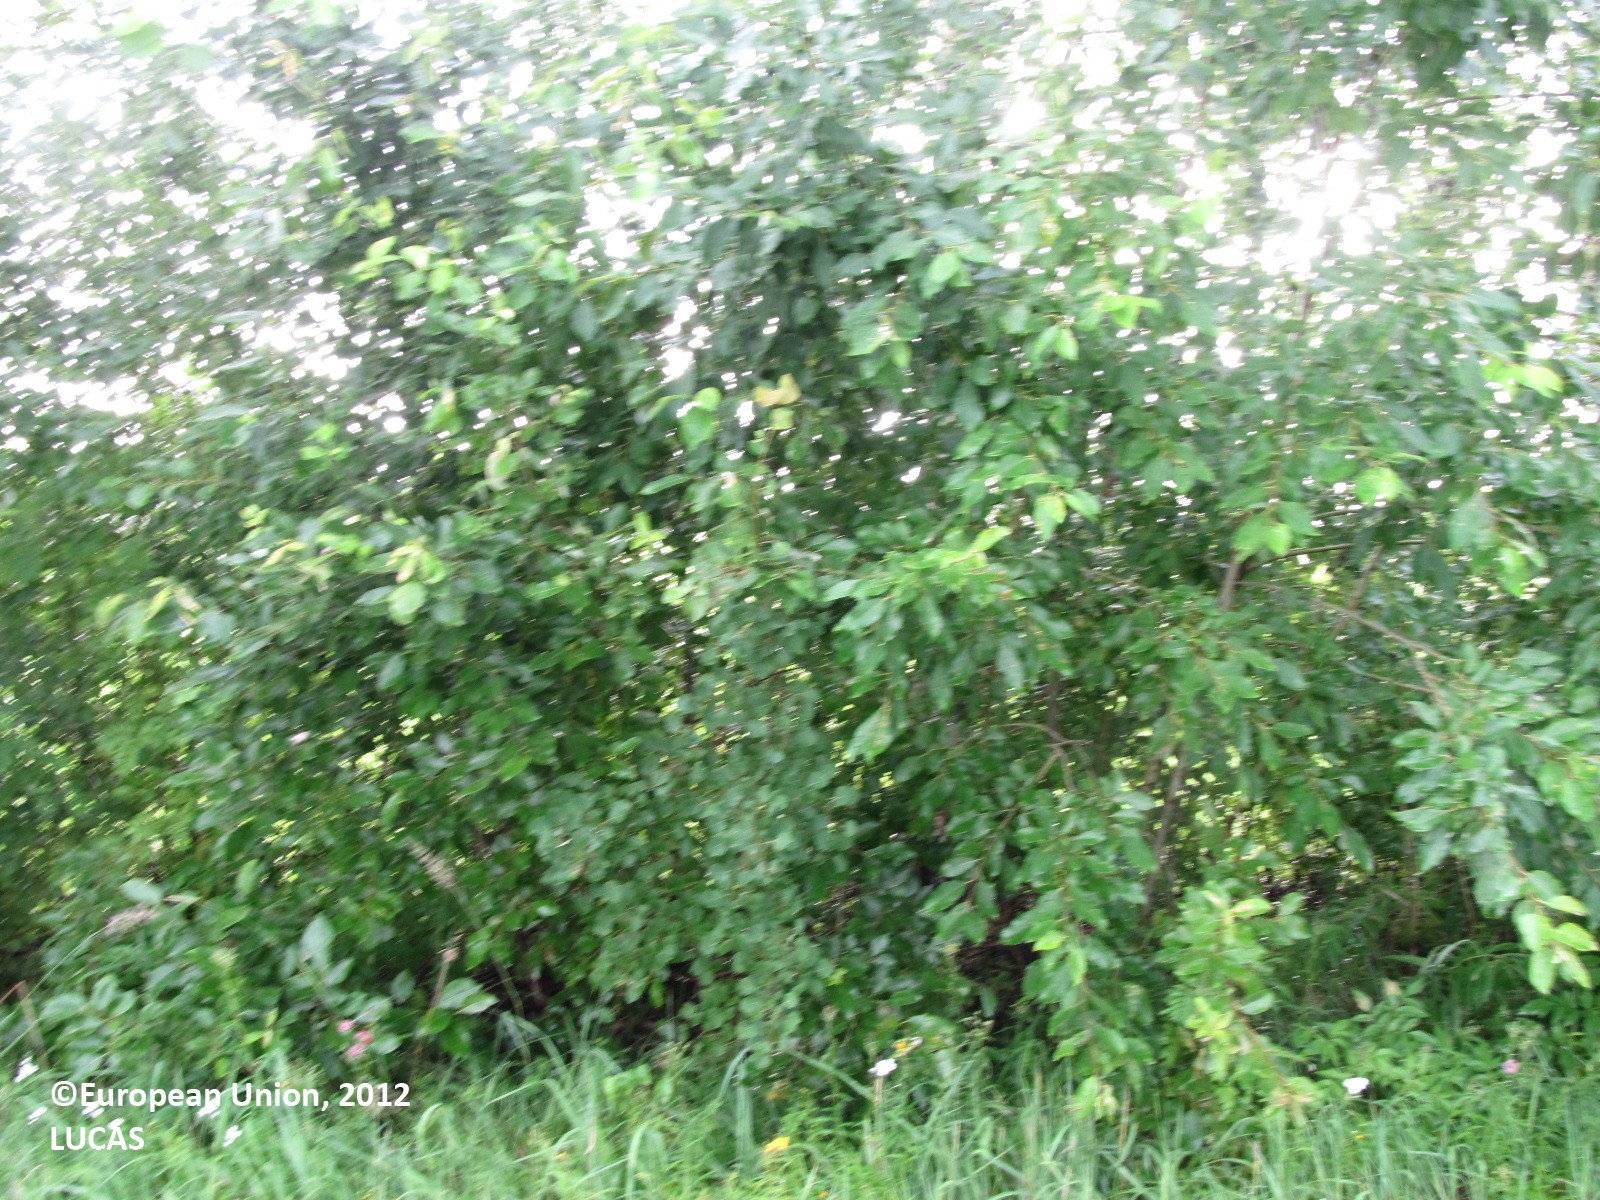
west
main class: Cropland
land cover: Oats
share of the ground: > 75 %
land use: Agriculture (excluding fallow land and kitchen gardens)
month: July
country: FI
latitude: 62.0141
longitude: 28.4477
